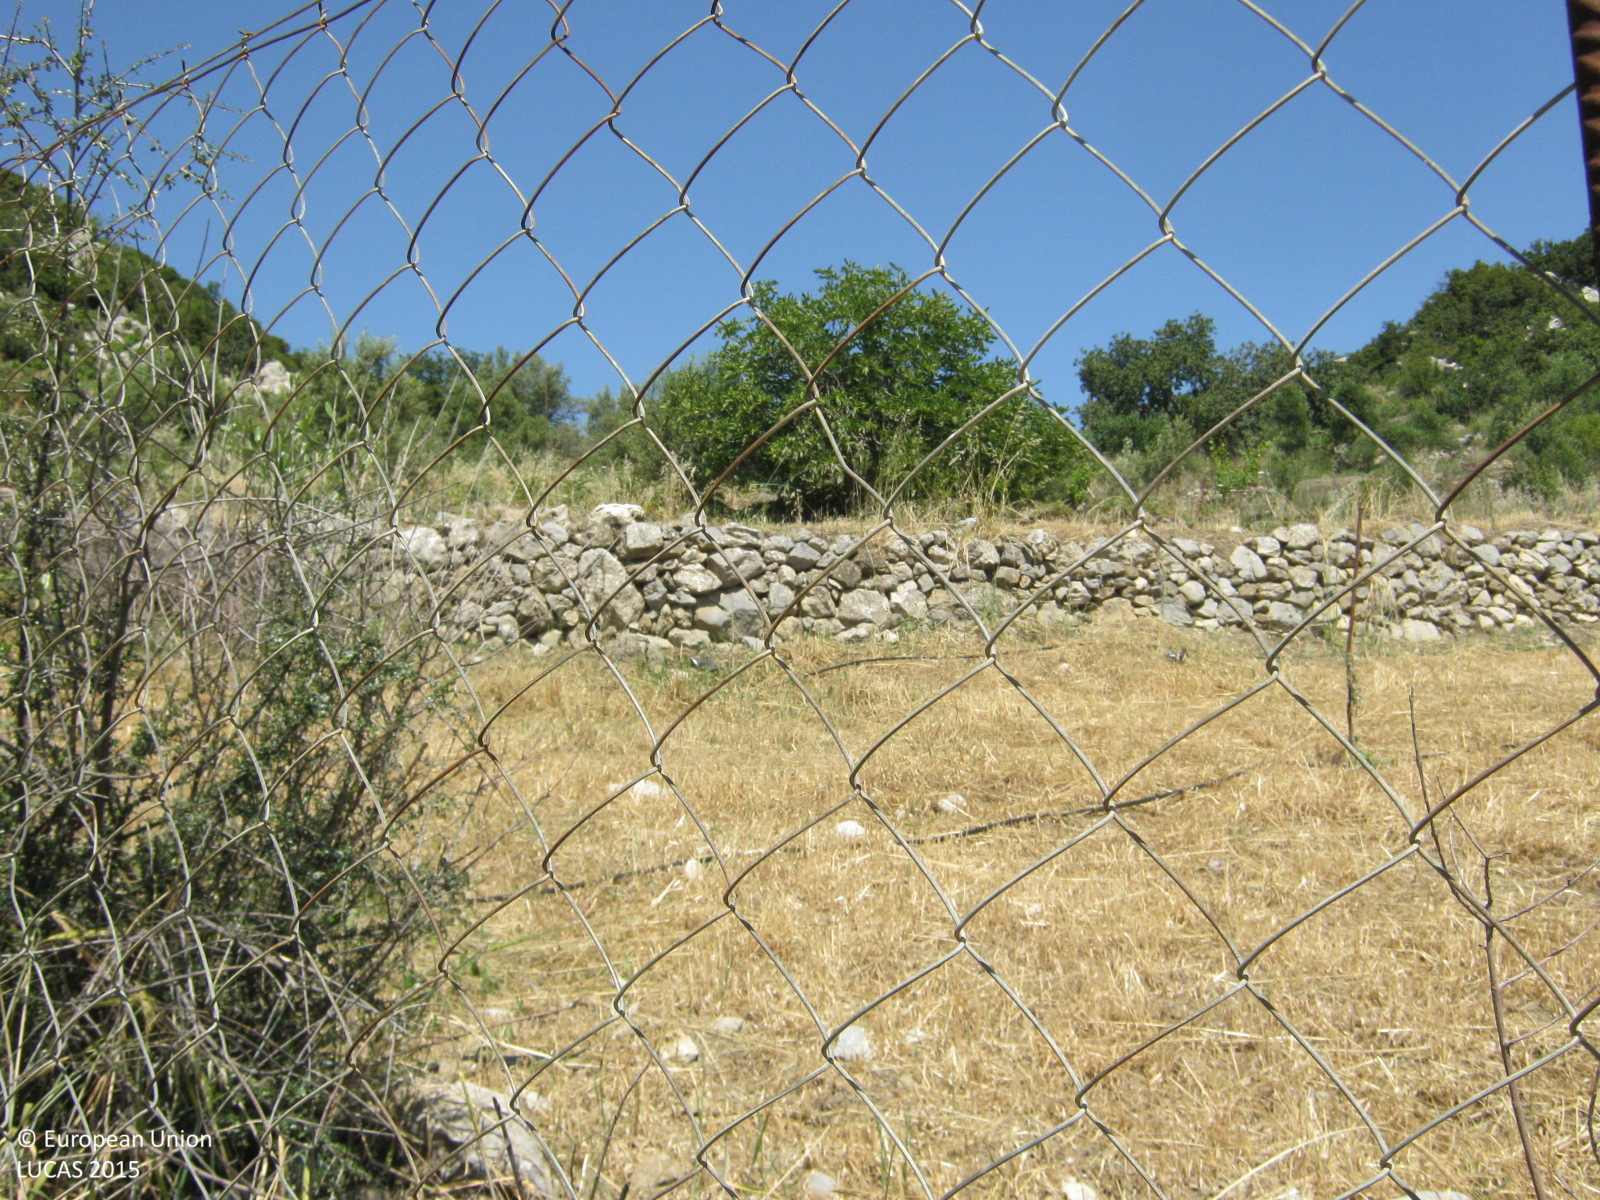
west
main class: Grassland
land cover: Grassland with sparse tree/shrub cover
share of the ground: > 75 %
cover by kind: herbaceous plants 95 %, broadleaved forest trees 5 %
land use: Agriculture (excluding fallow land and kitchen gardens)
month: June
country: GR
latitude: 35.3040
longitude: 24.8474
